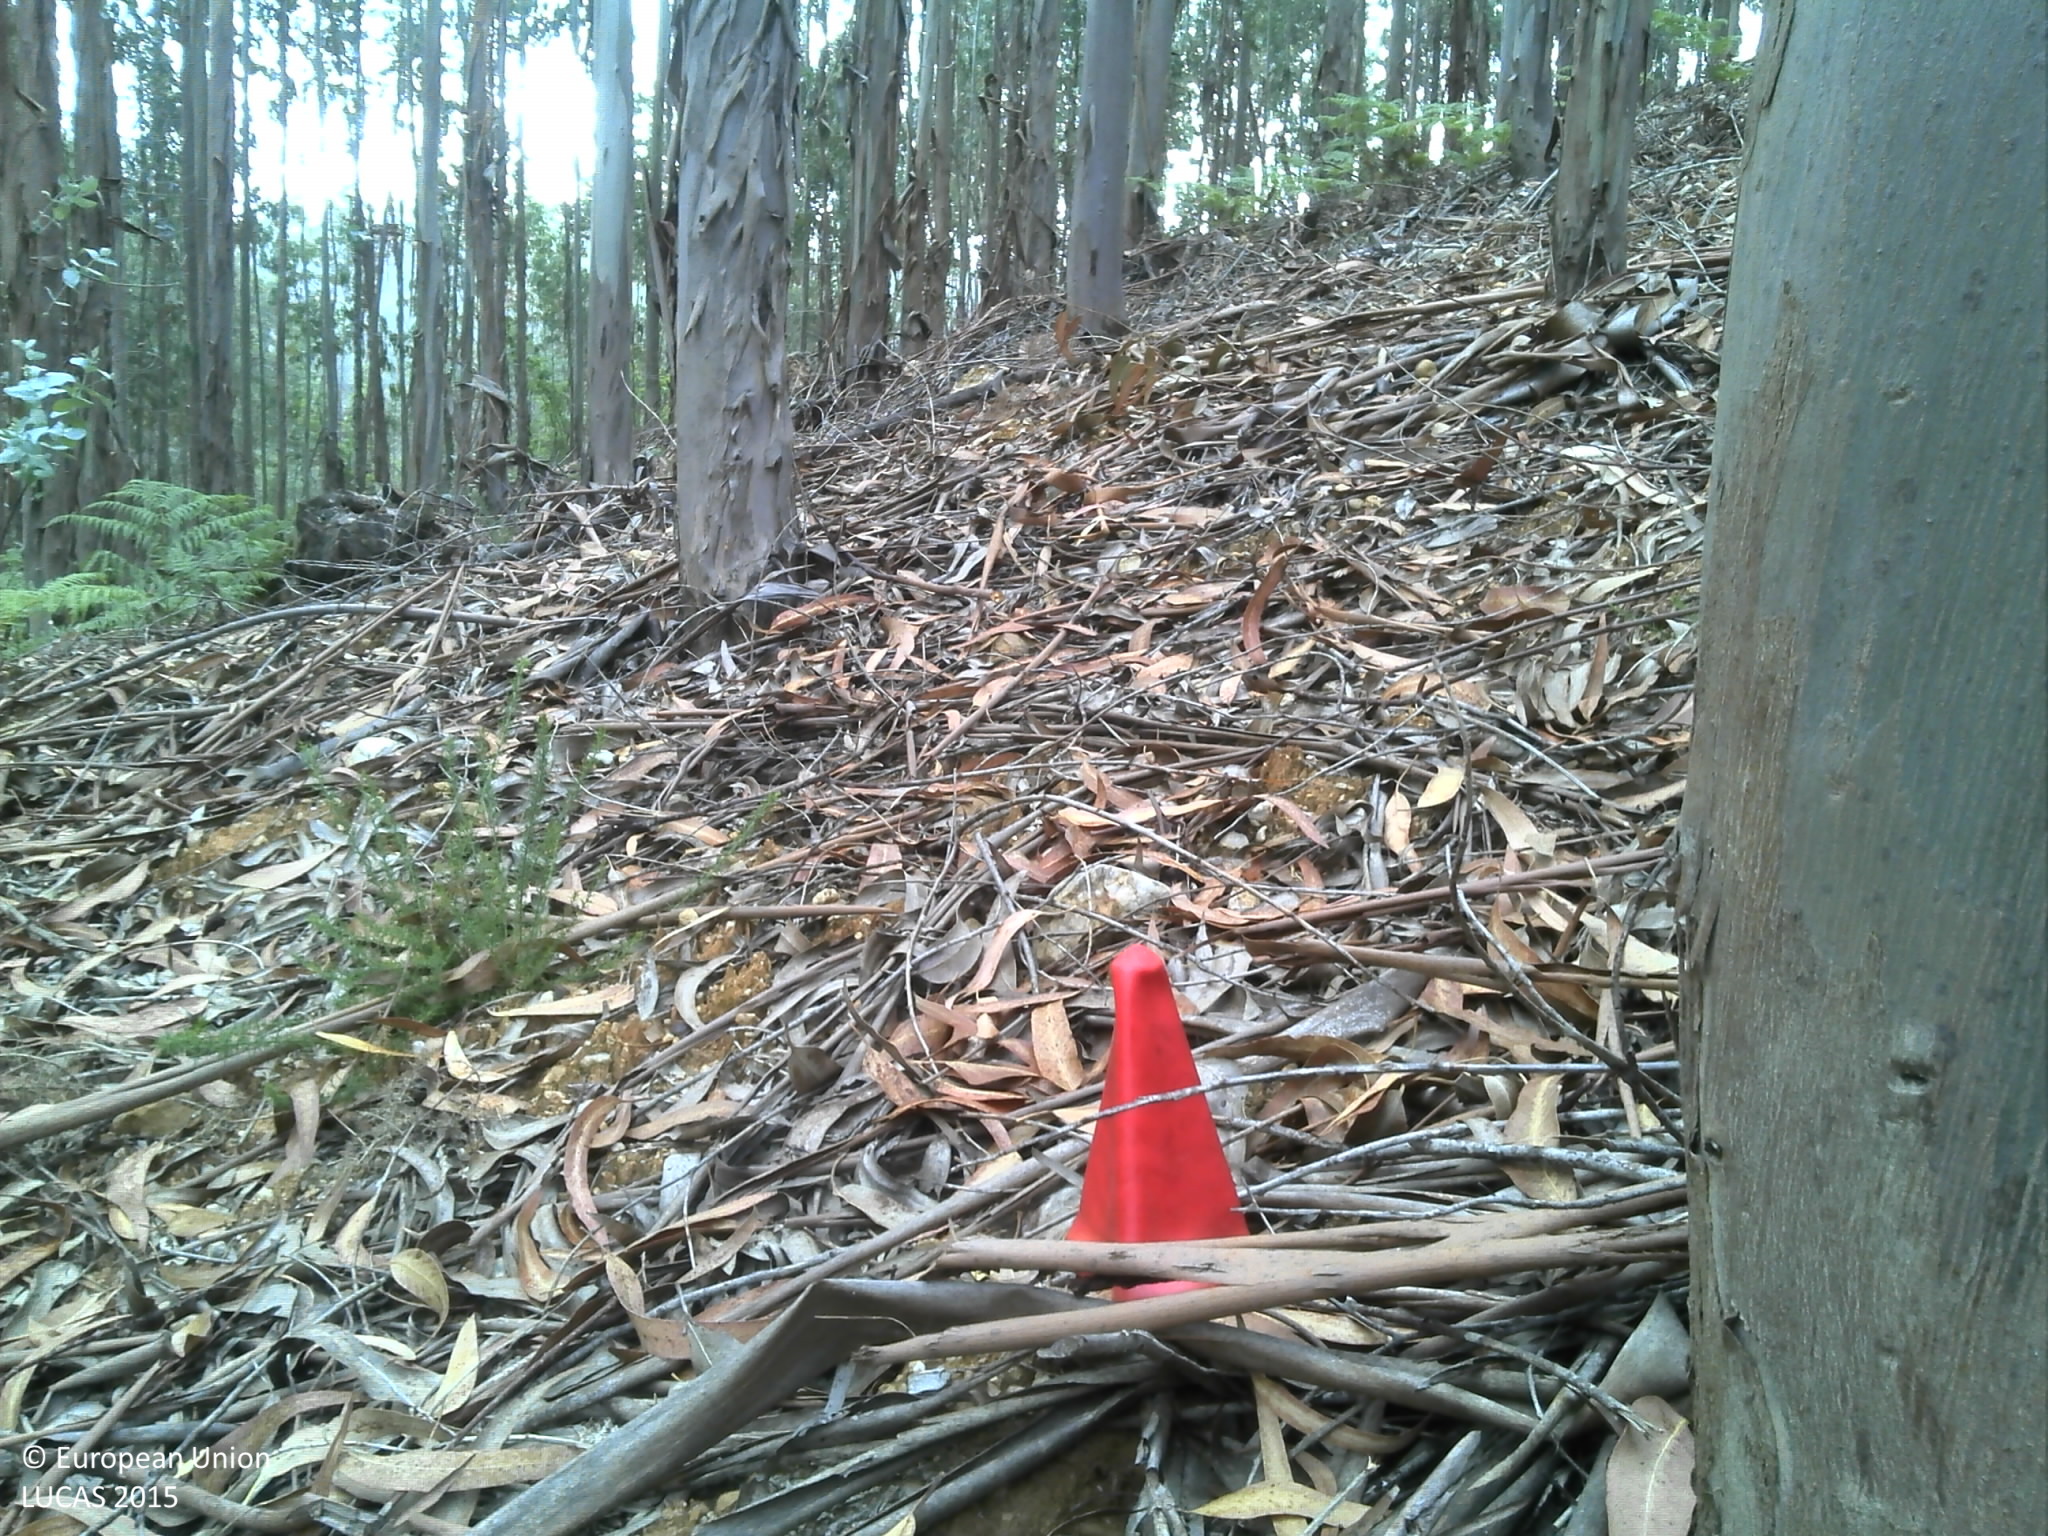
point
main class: Woodland
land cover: Broadleaved woodland
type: exotic forest
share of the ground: 50 - 75 %
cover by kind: broadleaved forest trees 60 %, unconsolidated bare surface 35 %, shrubs 5 %
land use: Forestry
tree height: > 5 m
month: July
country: PT
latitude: 40.2985
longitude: -8.1358
